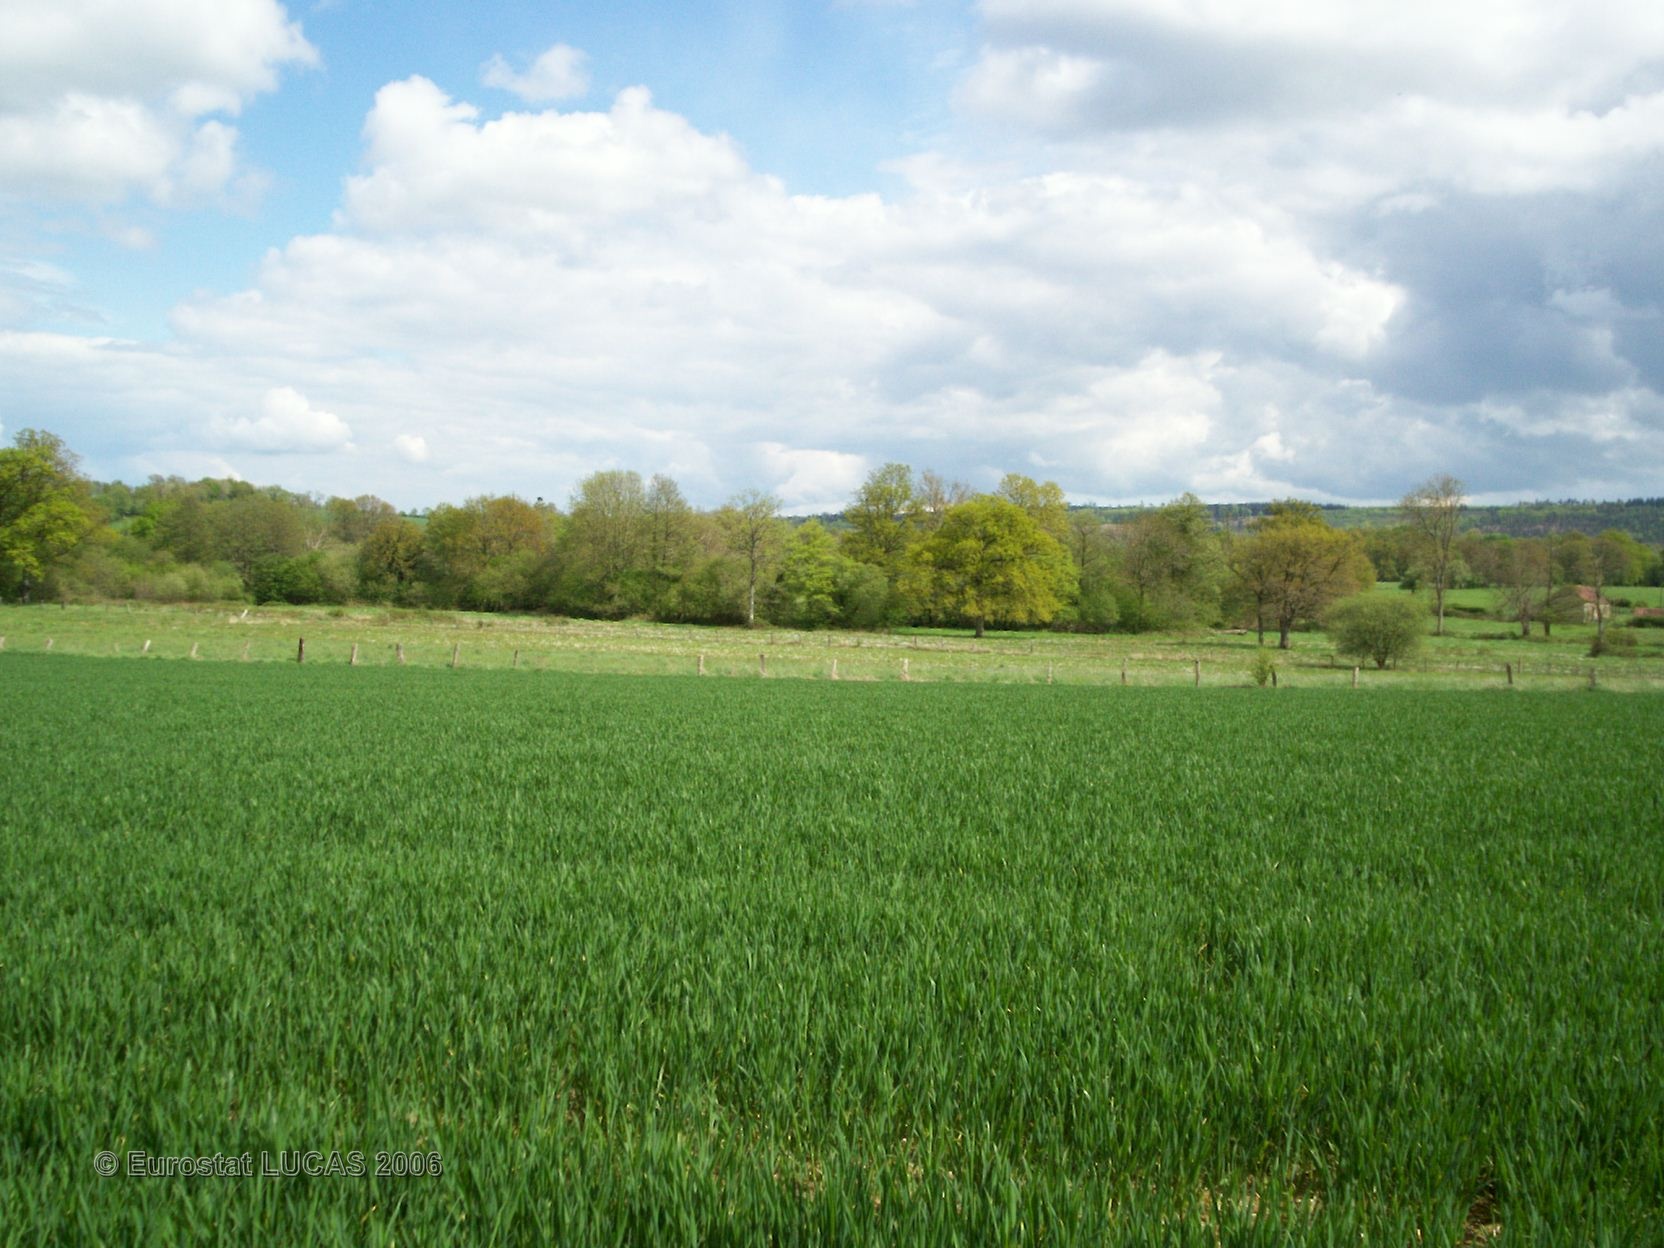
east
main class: Cropland
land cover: Common wheat
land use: Agriculture (excluding fallow land and kitchen gardens)
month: May
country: FR
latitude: 48.5890
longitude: 0.0603
